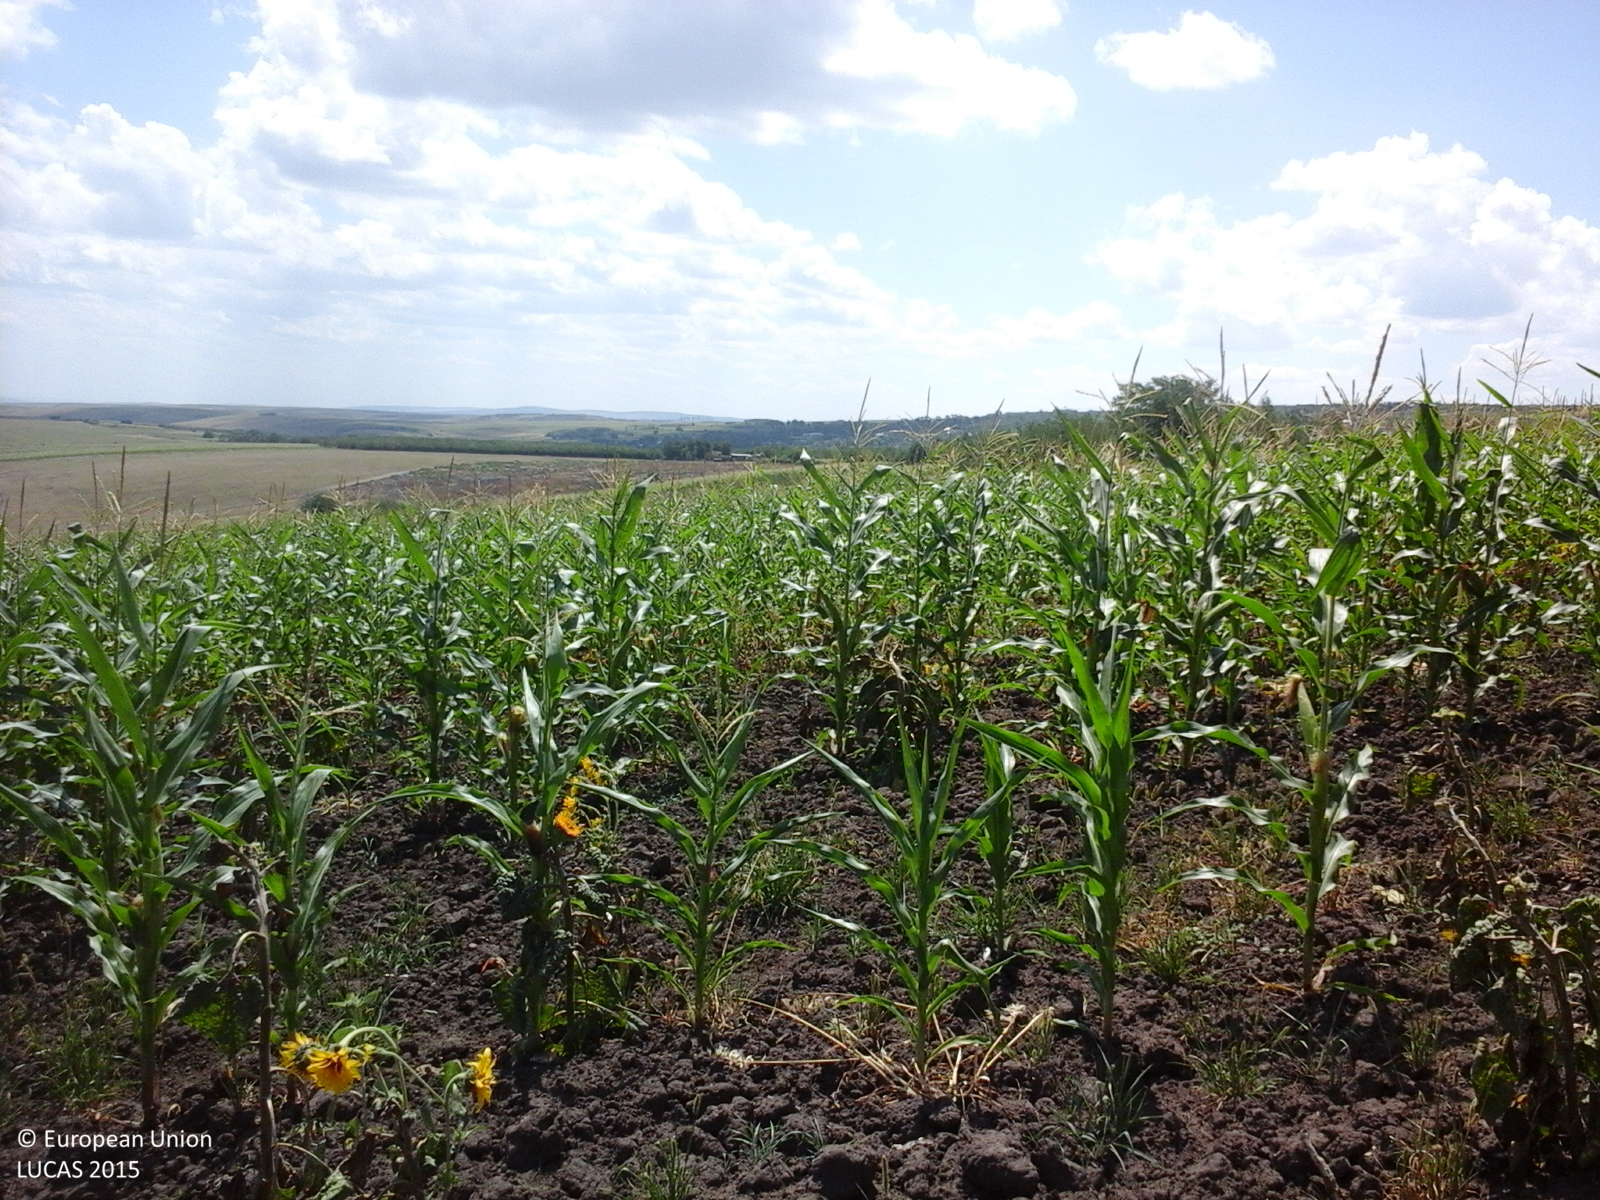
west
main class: Cropland
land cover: Maize
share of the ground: 25 - 50 %
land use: Agriculture (excluding fallow land and kitchen gardens)
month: July
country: RO
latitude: 46.3920
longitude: 27.8995
